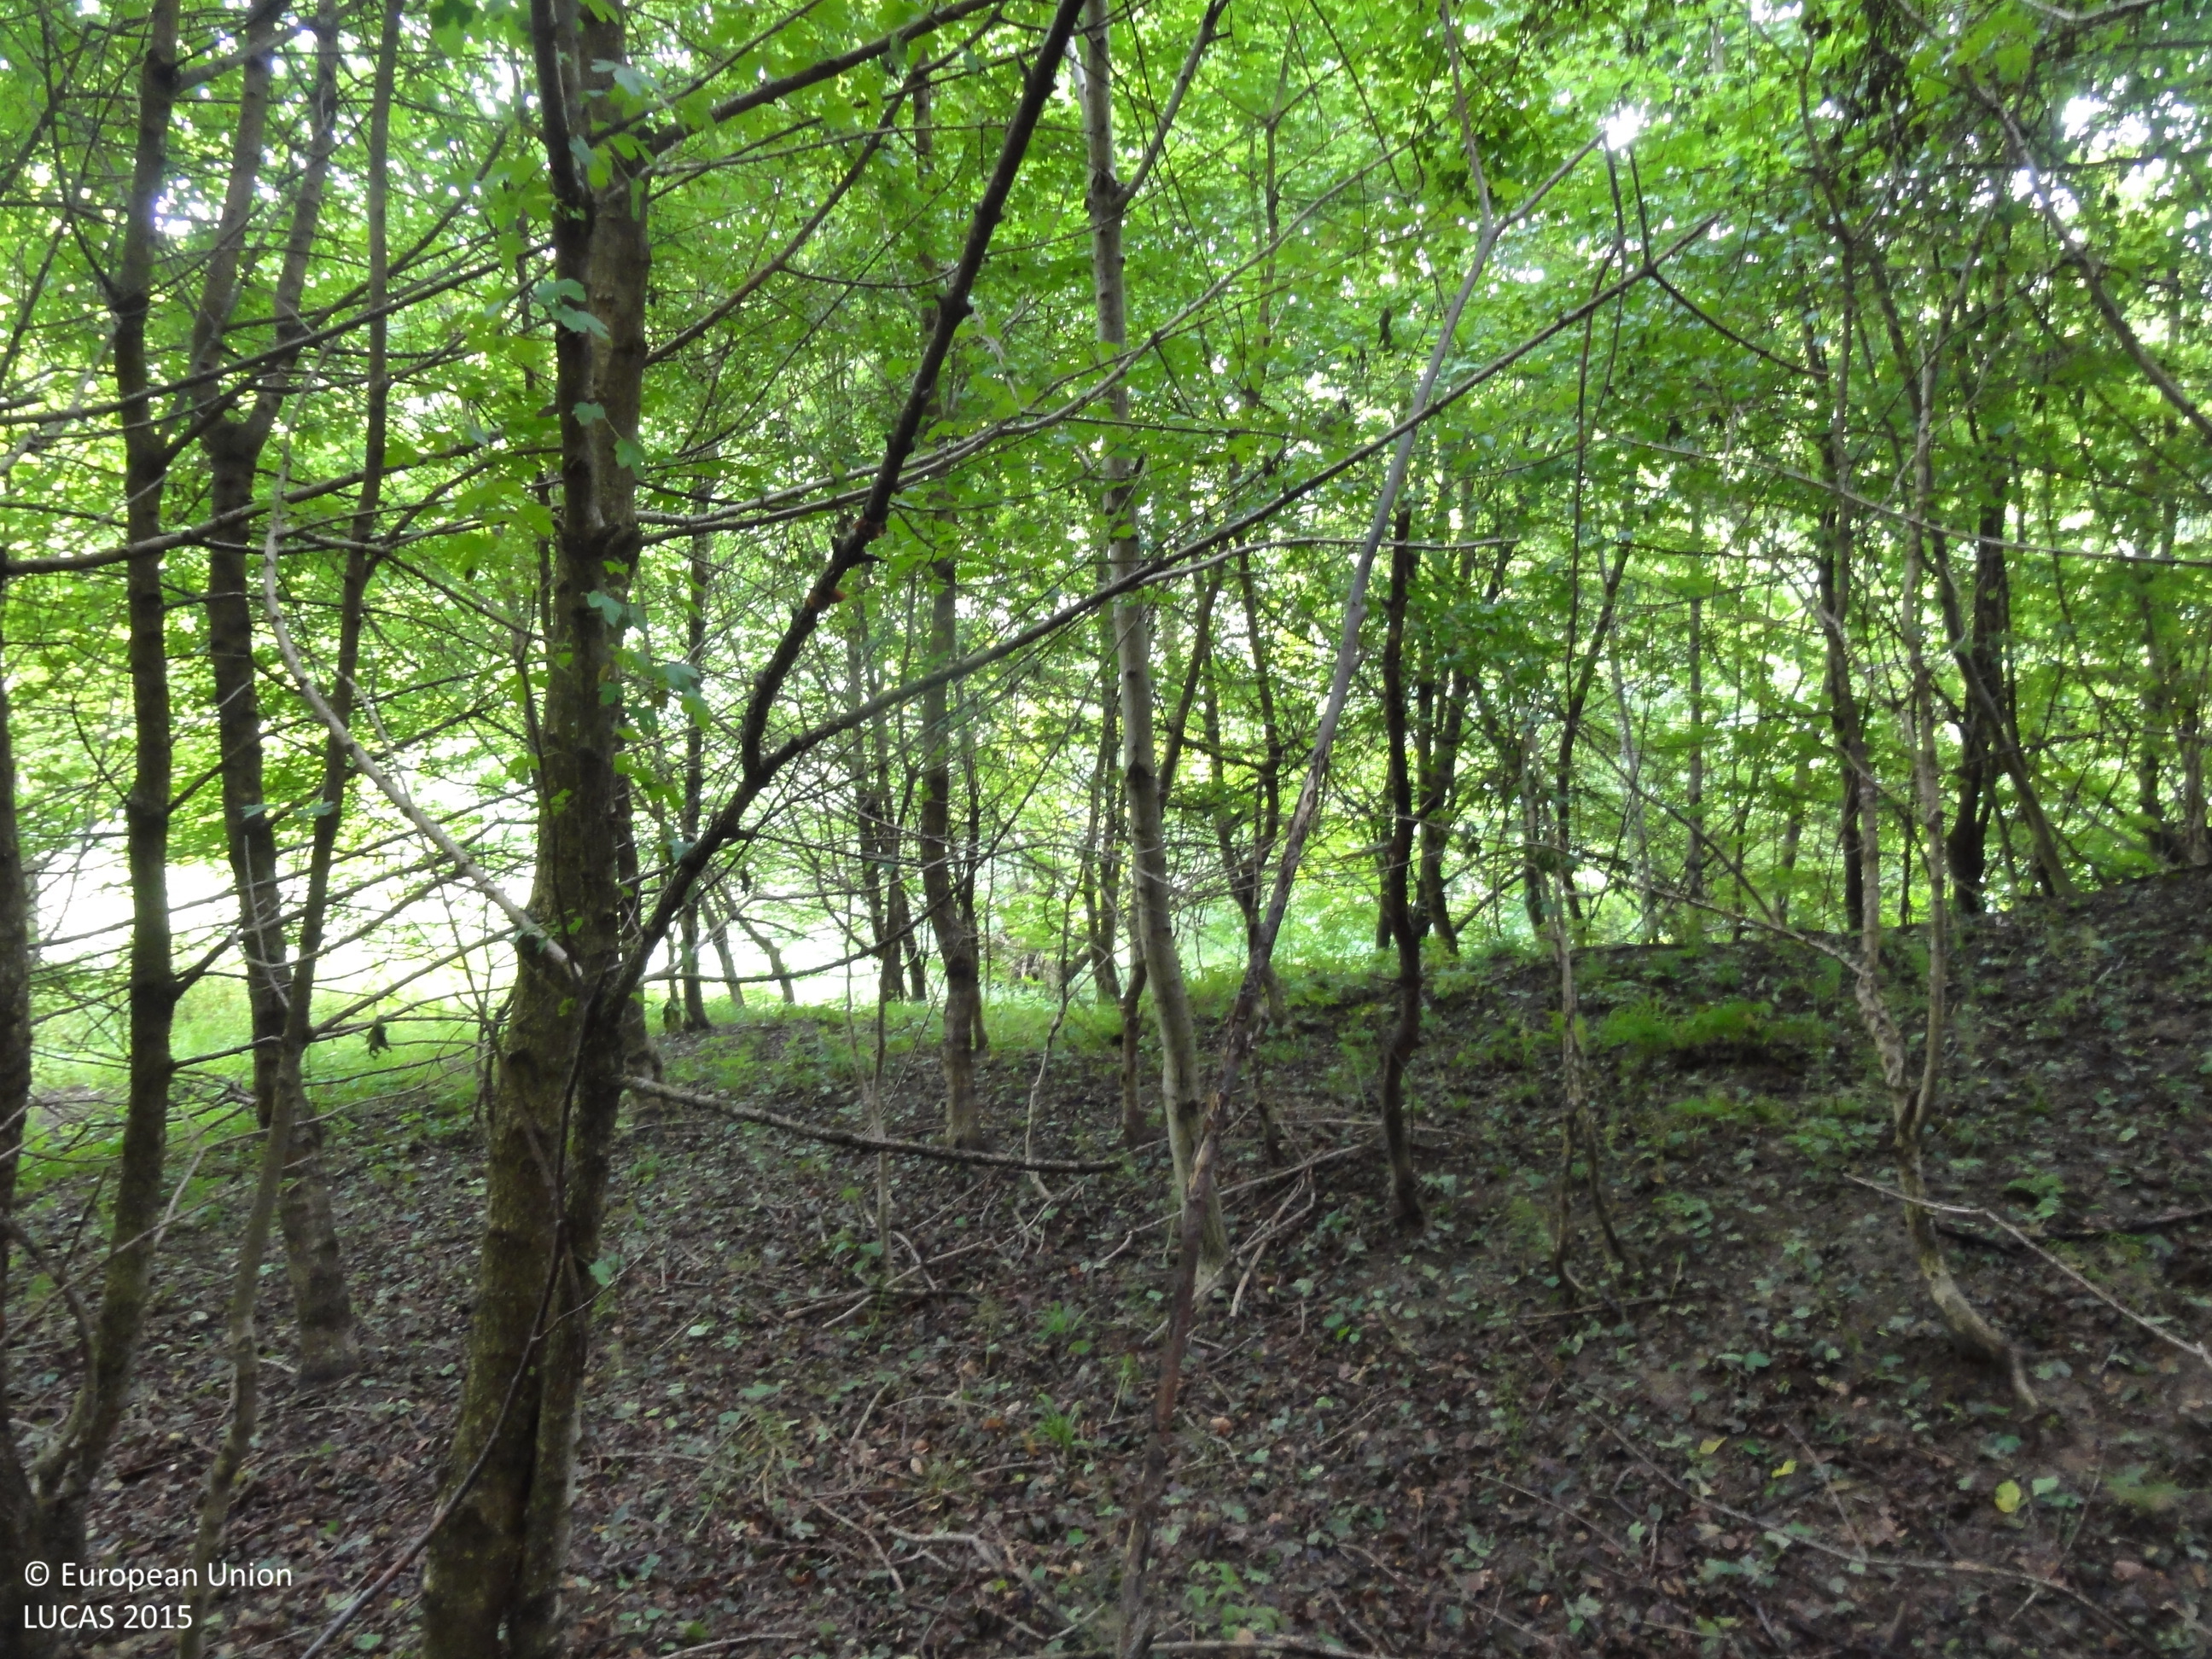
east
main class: Woodland
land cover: Broadleaved woodland
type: mesophytic deciduous forest
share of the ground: > 75 %
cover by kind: broadleaved forest trees 100 %
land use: Forestry
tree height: > 5 m
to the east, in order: Broadleaved woodland; Tracks; Broadleaved woodland; Tracks; Broadleaved woodland; Rivers and streams; Broadleaved woodland
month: June
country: SI
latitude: 46.6748
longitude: 15.5811
